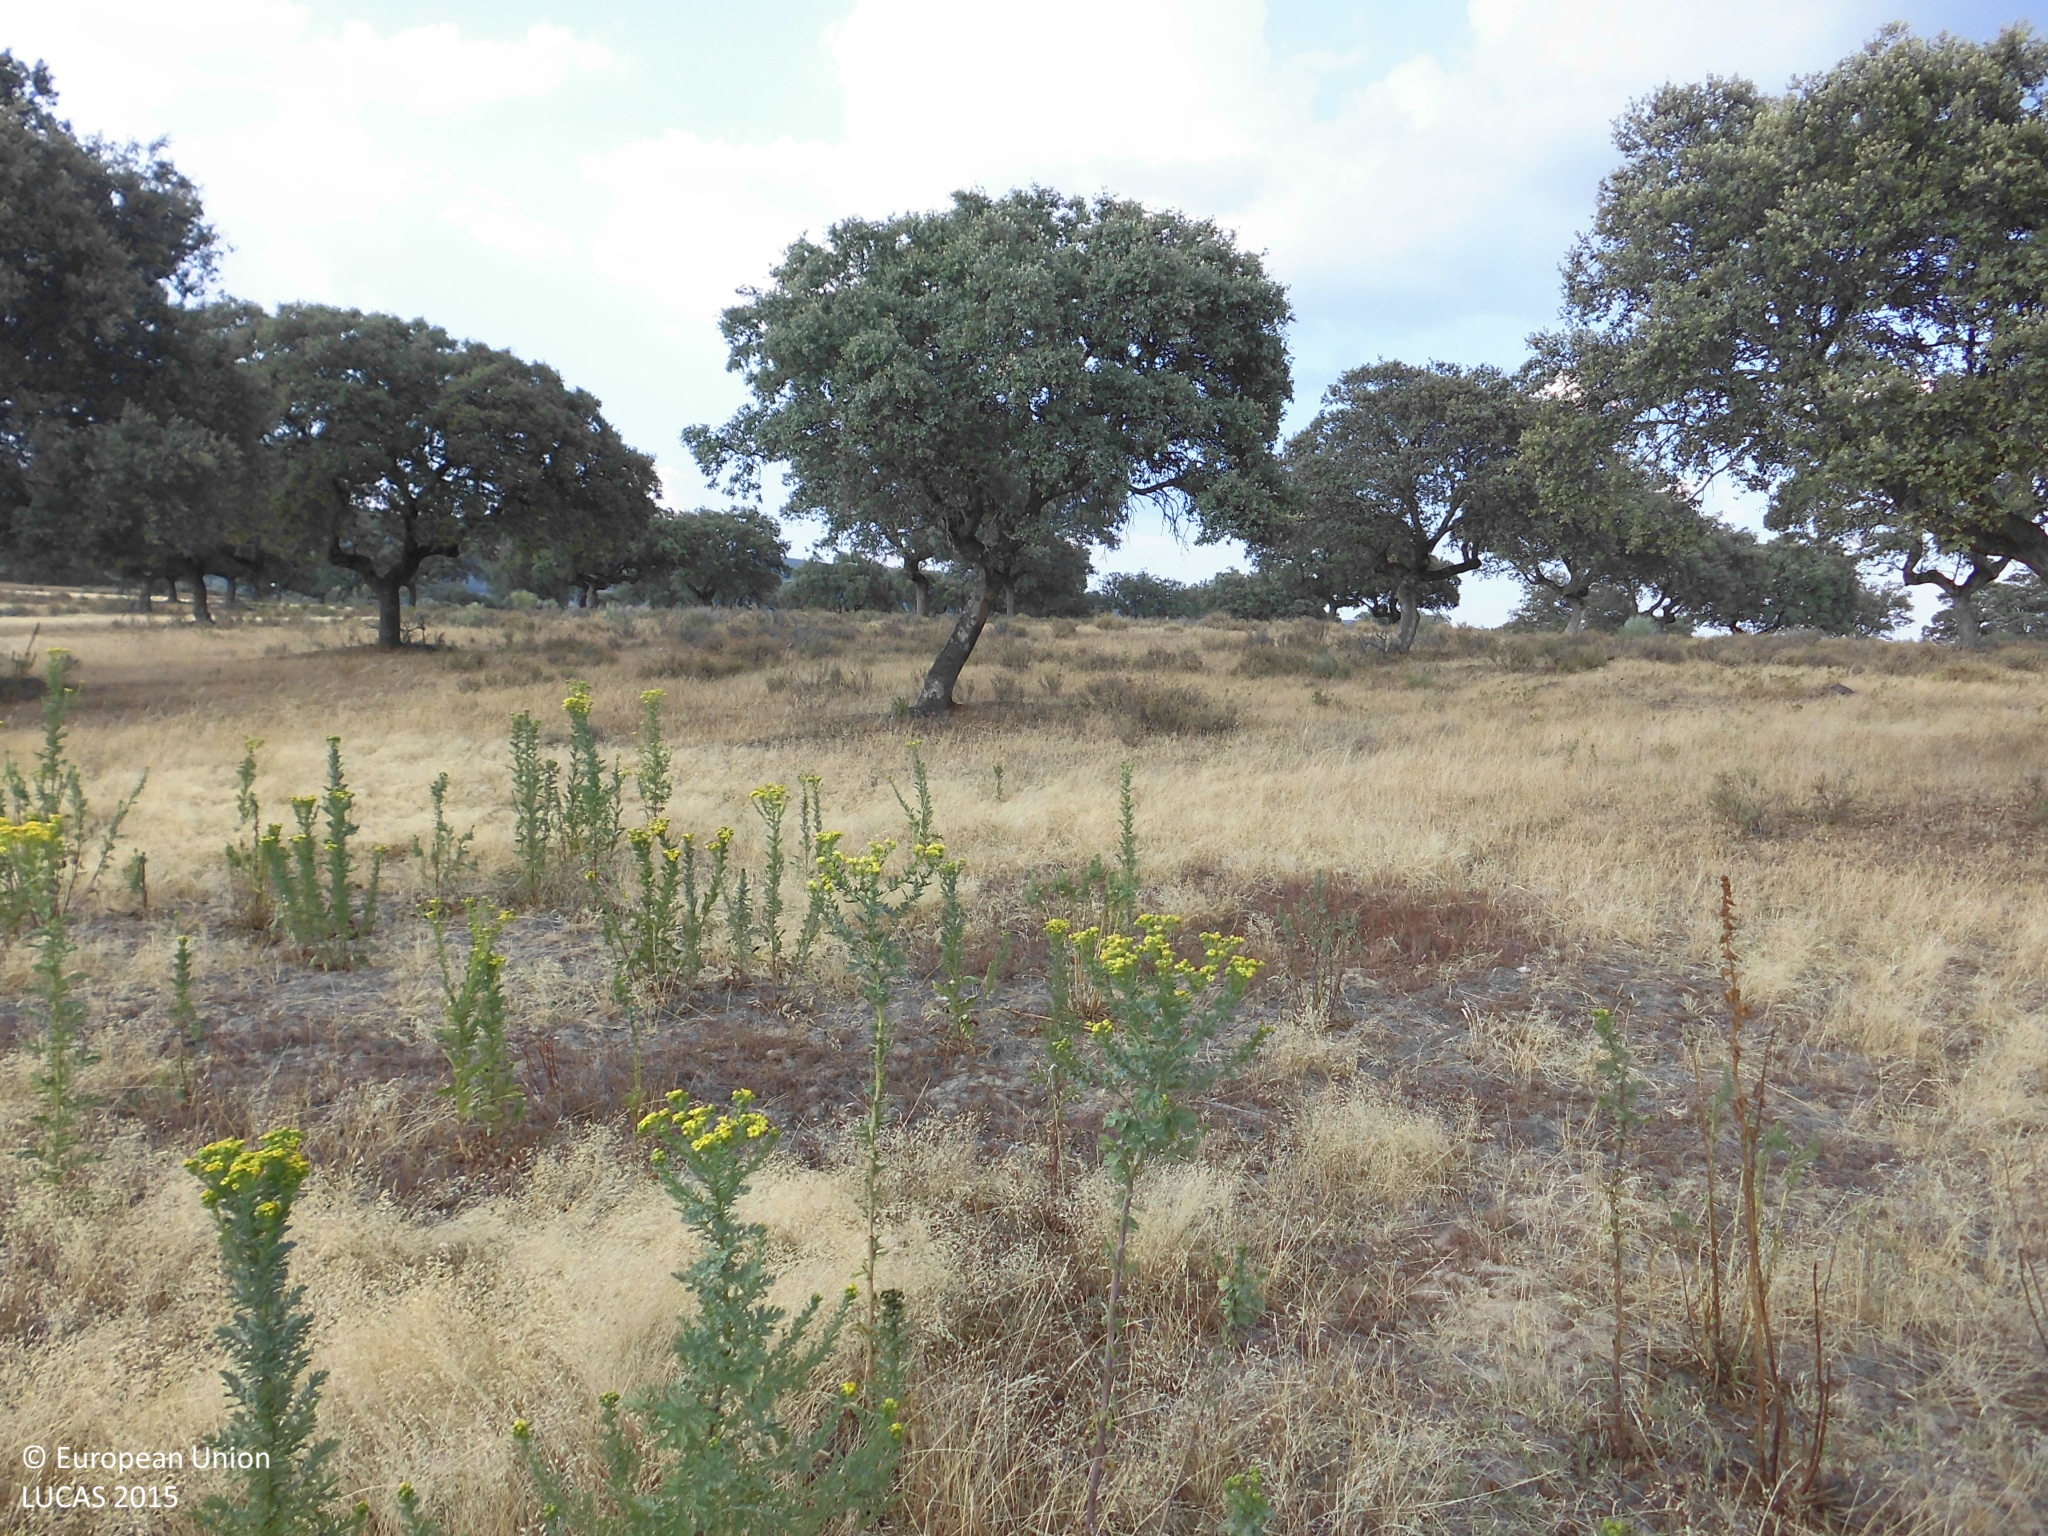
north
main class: Woodland
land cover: Broadleaved woodland
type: broadleaved evergreen forest
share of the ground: 10 - 25 %
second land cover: Grassland without tree/shrub cover
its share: > 75 %
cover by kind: herbaceous plants 90 %, broadleaved forest trees 10 %
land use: Forestry
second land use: Agriculture (excluding fallow land and kitchen gardens)
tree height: > 5 m
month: June
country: ES
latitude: 39.8164
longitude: -6.1794
